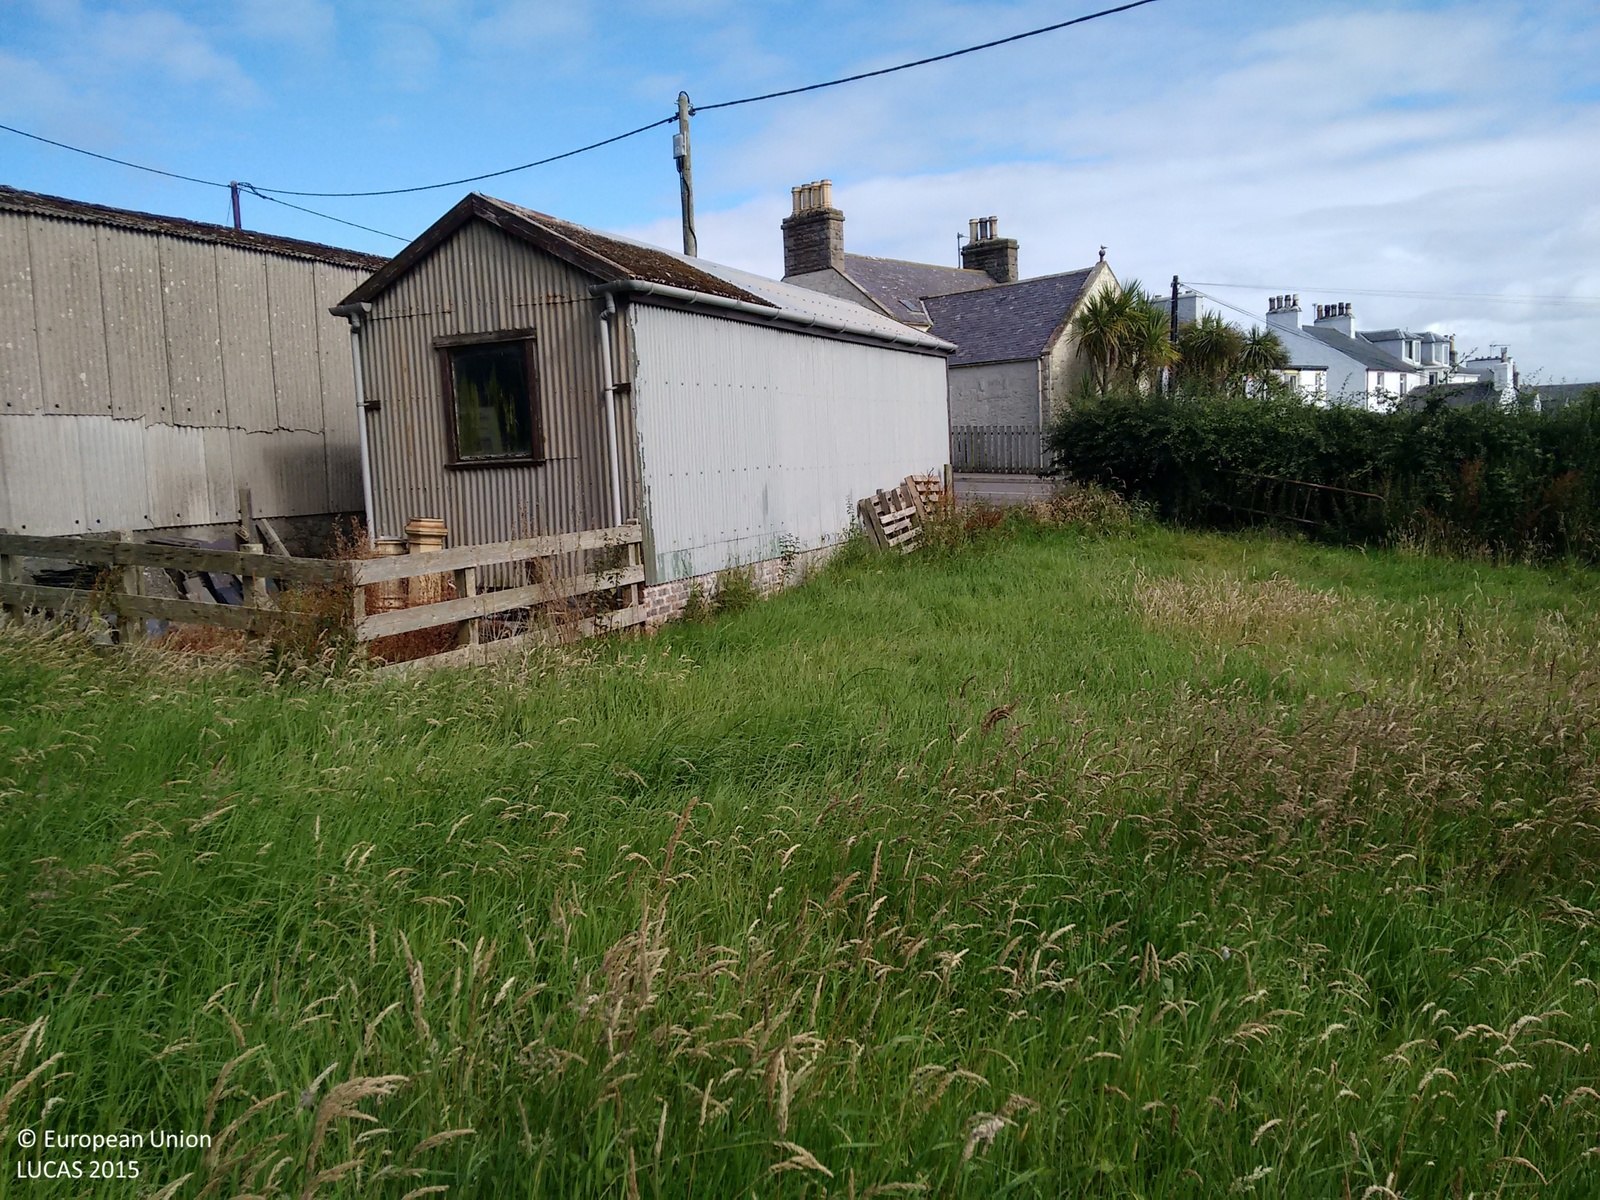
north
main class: Grassland
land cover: Grassland with sparse tree/shrub cover
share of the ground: > 75 %
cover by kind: herbaceous plants 95 %, broadleaved forest trees 5 %
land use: Agriculture (excluding fallow land and kitchen gardens)
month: August
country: GB
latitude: 54.6885
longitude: -4.8956
